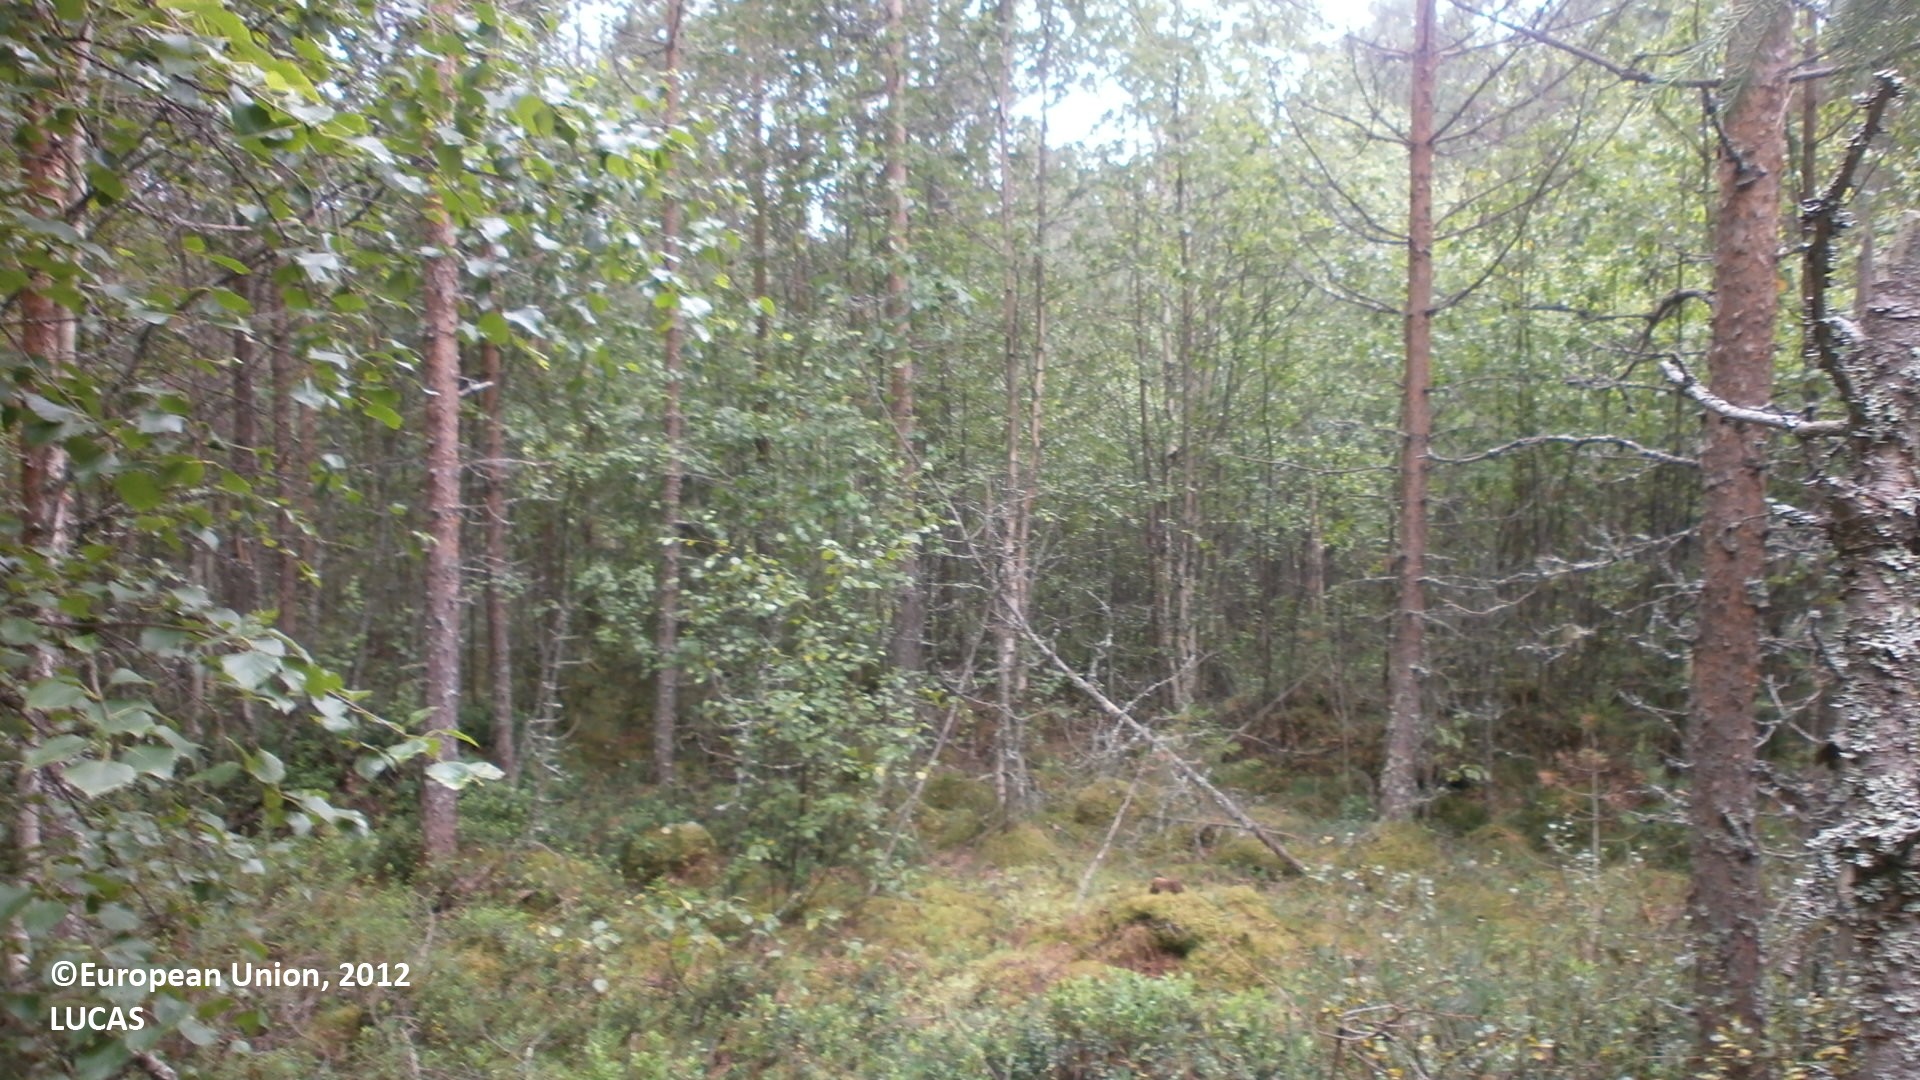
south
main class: Woodland
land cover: Pine dominated mixed woodland
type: boreal forest
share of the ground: 50 - 75 %
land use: Forestry
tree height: > 5 m
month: July
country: FI
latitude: 64.2694
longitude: 24.4183
